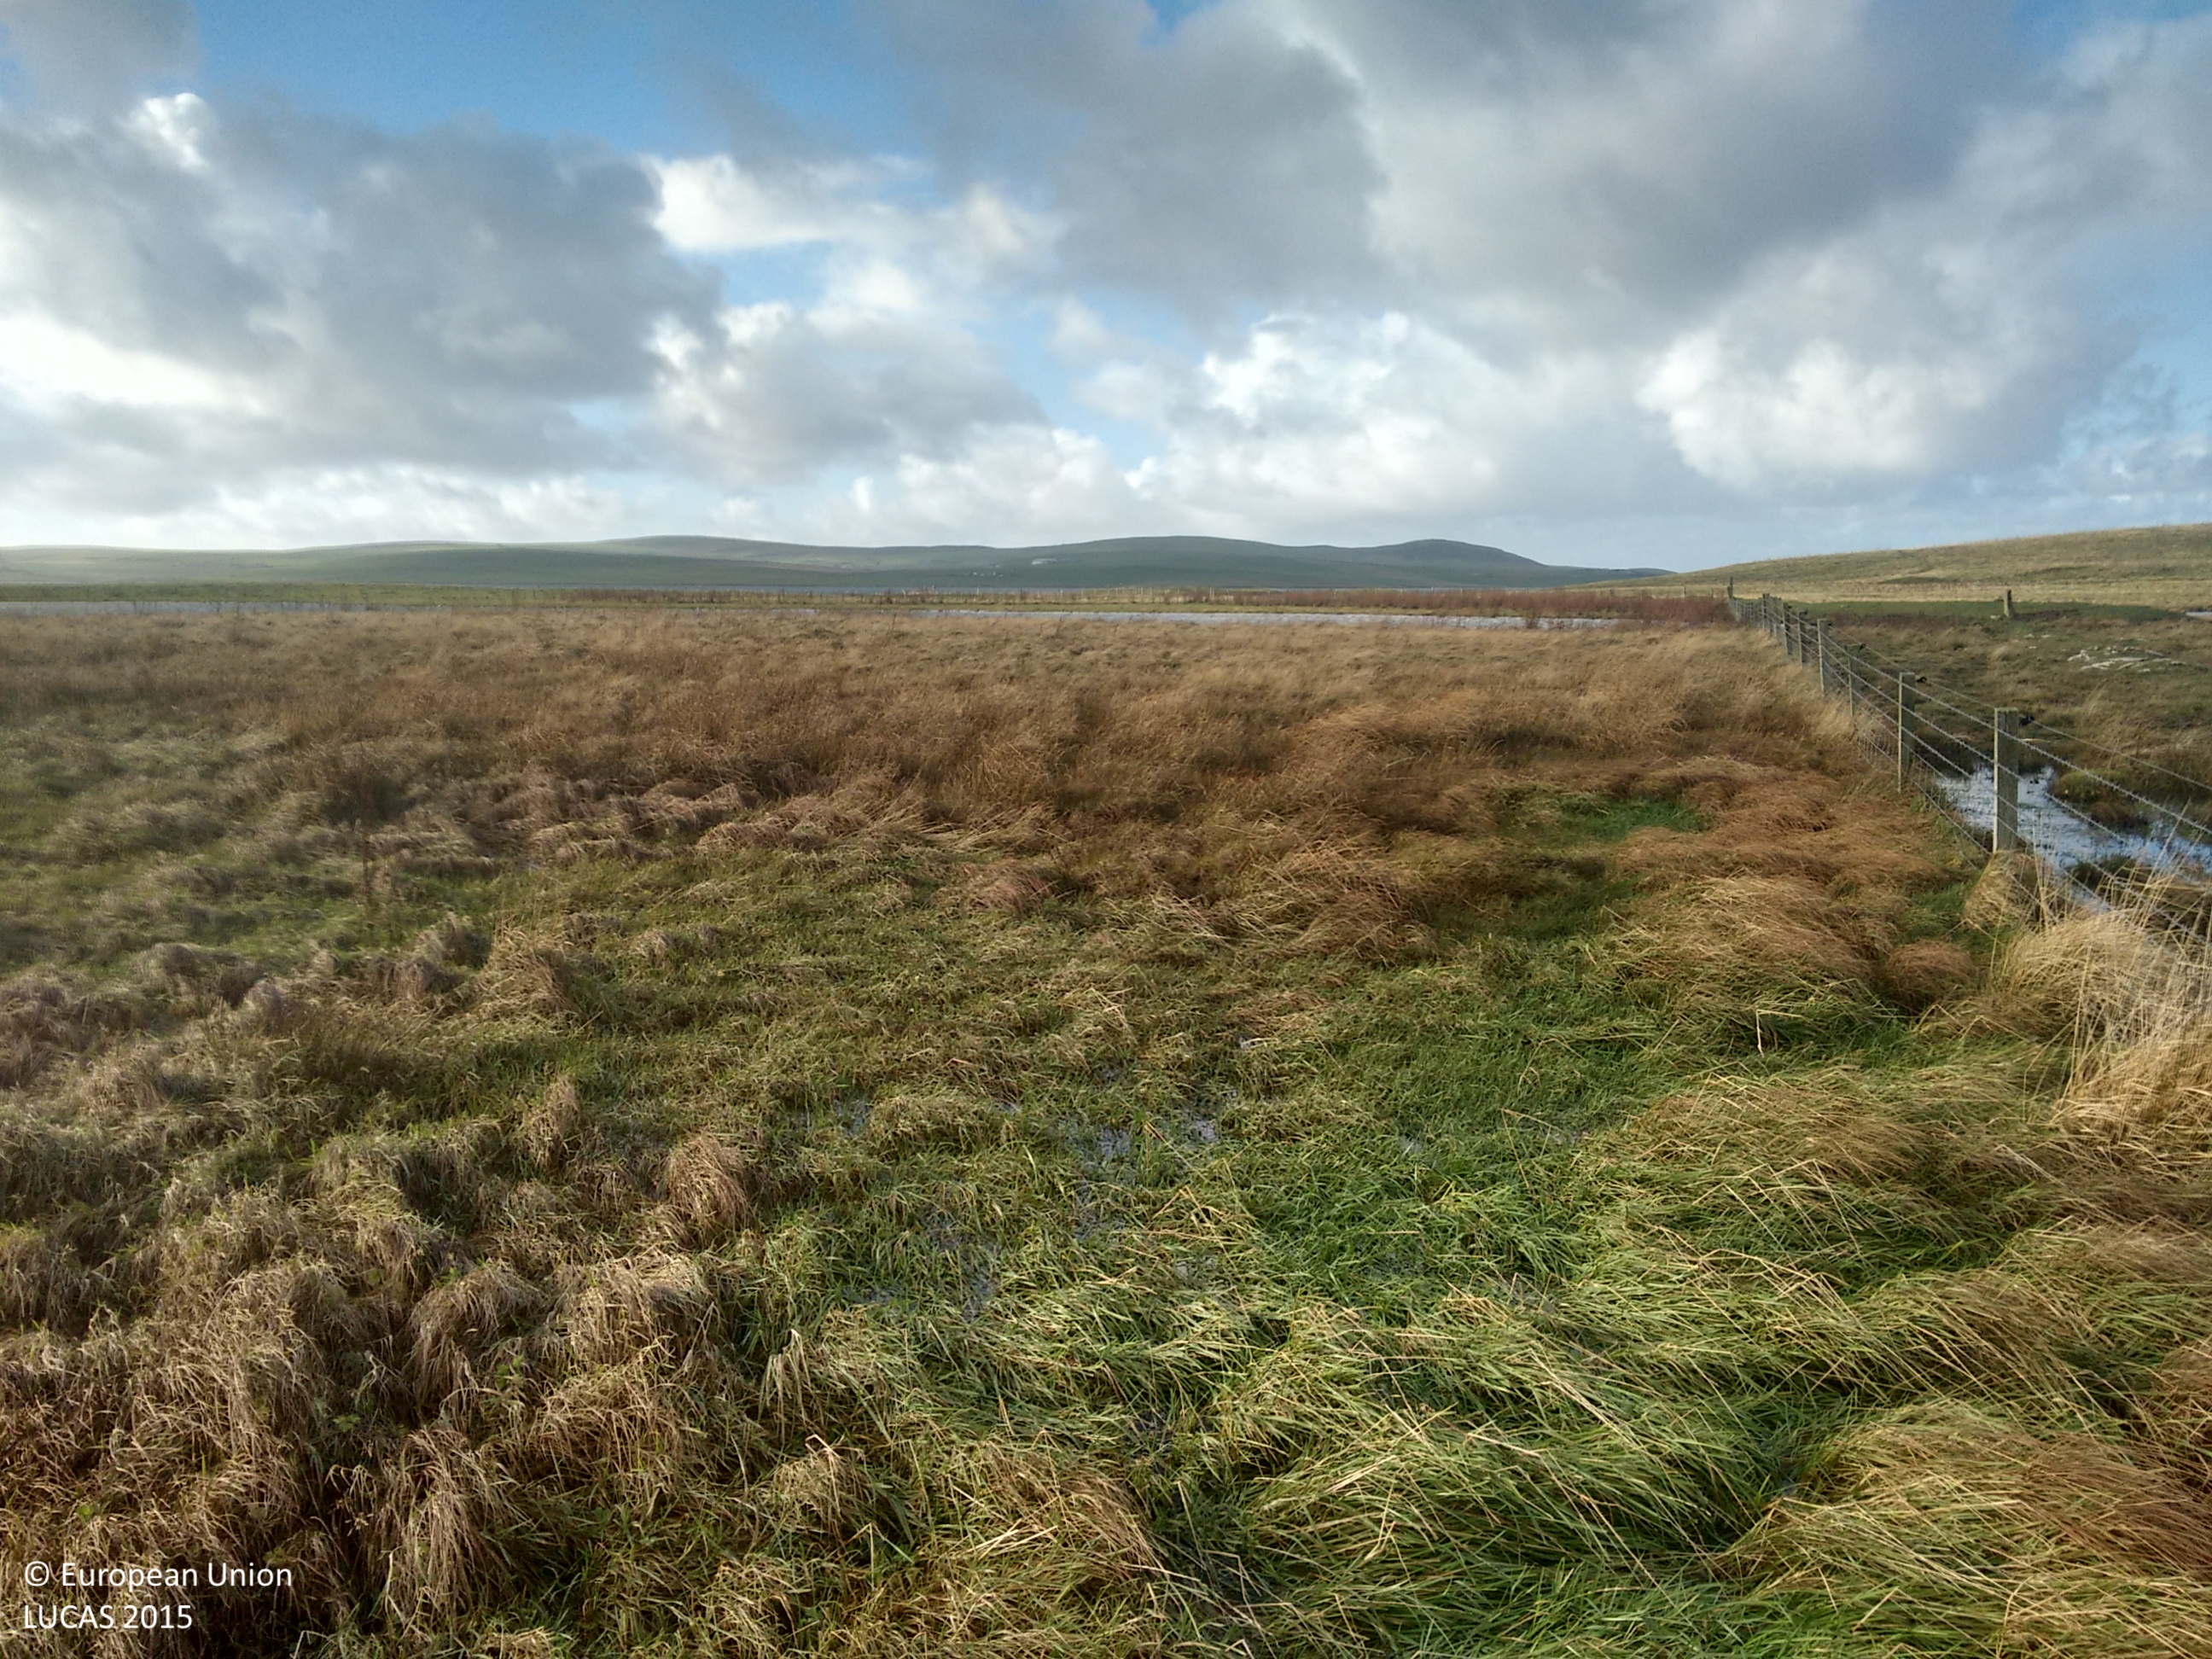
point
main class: Grassland
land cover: Grassland without tree/shrub cover
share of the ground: > 75 %
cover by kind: herbaceous plants 100 %
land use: Agriculture (excluding fallow land and kitchen gardens)
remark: Temporary flooded
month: November
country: GB
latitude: 59.0046
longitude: -3.2357
